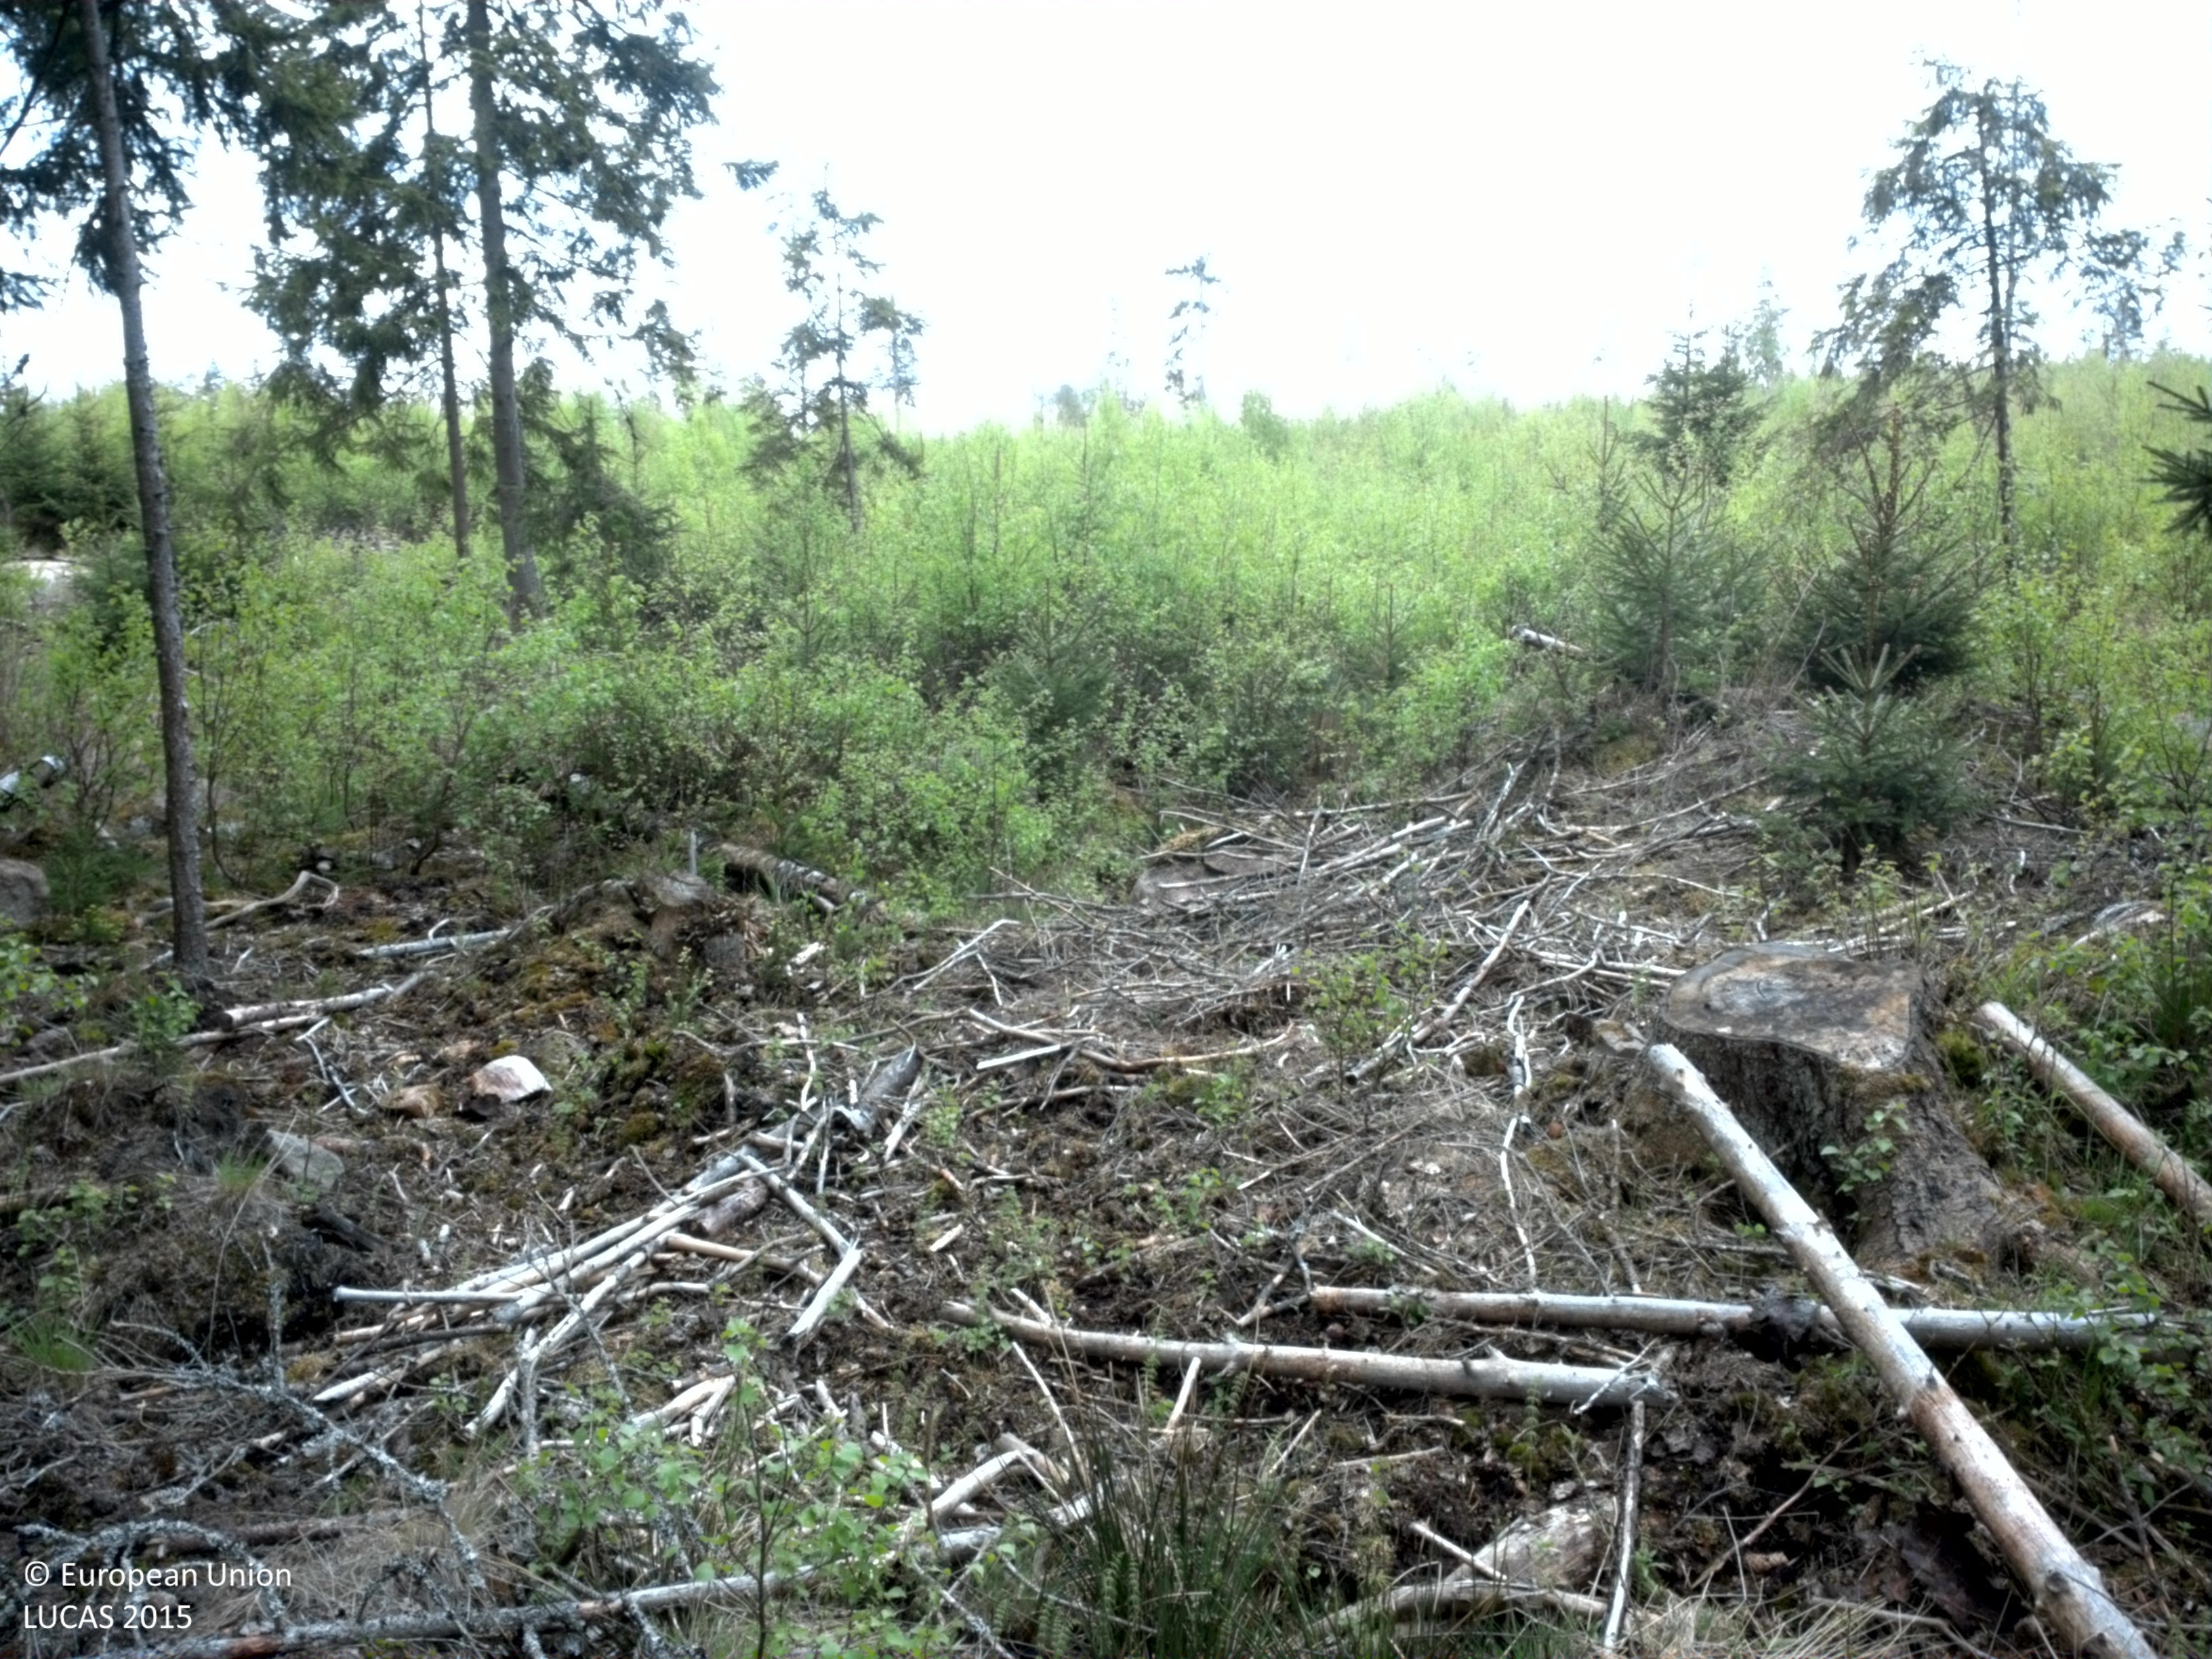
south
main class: Woodland
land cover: Spruce dominated mixed woodland
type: boreal forest
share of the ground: 25 - 50 %
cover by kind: coniferous forest trees 30 %, herbaceous plants 20 %, unconsolidated bare surface 15 %, broadleaved forest trees 10 %, shrubs 10 %, lichens and mosses 10 %, consolidated bare surface 5 %
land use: Forestry
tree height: > 5 m
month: May
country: SE
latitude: 56.6563
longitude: 15.2672
